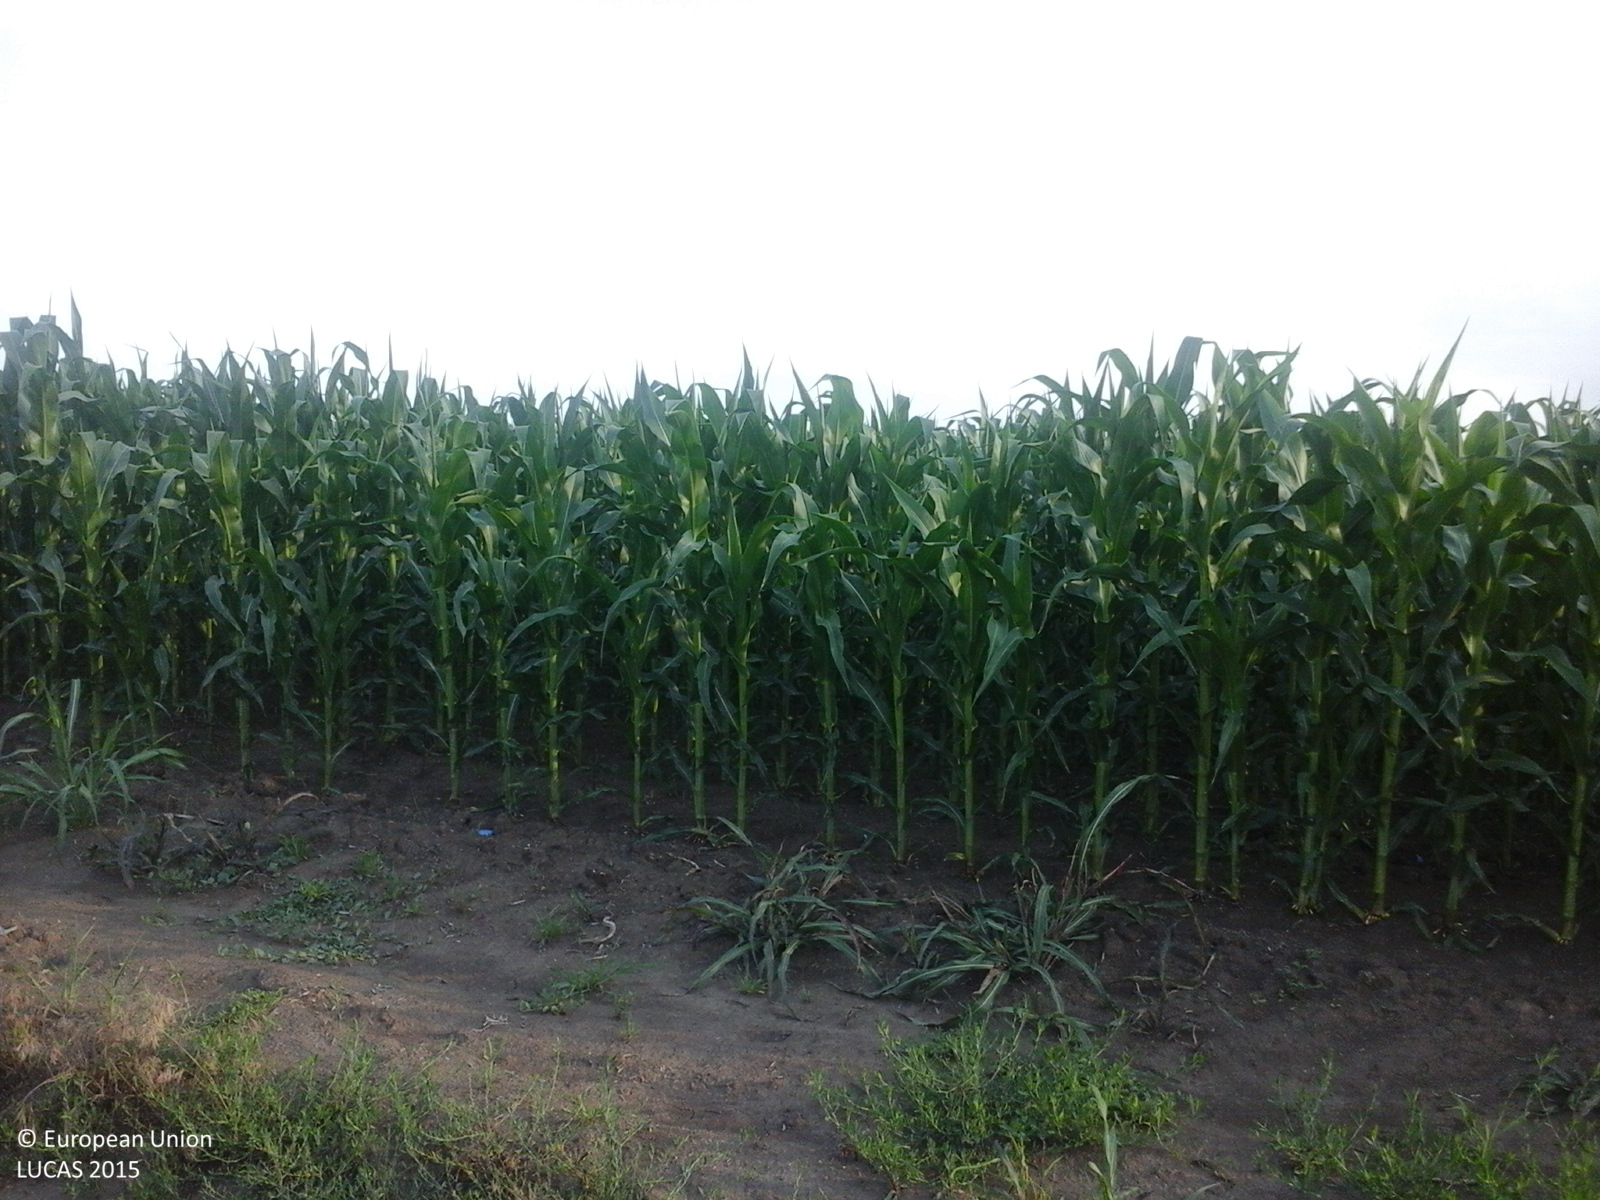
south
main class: Cropland
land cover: Common wheat
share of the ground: > 75 %
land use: Agriculture (excluding fallow land and kitchen gardens)
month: July
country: RO
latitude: 43.7318
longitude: 25.5925
